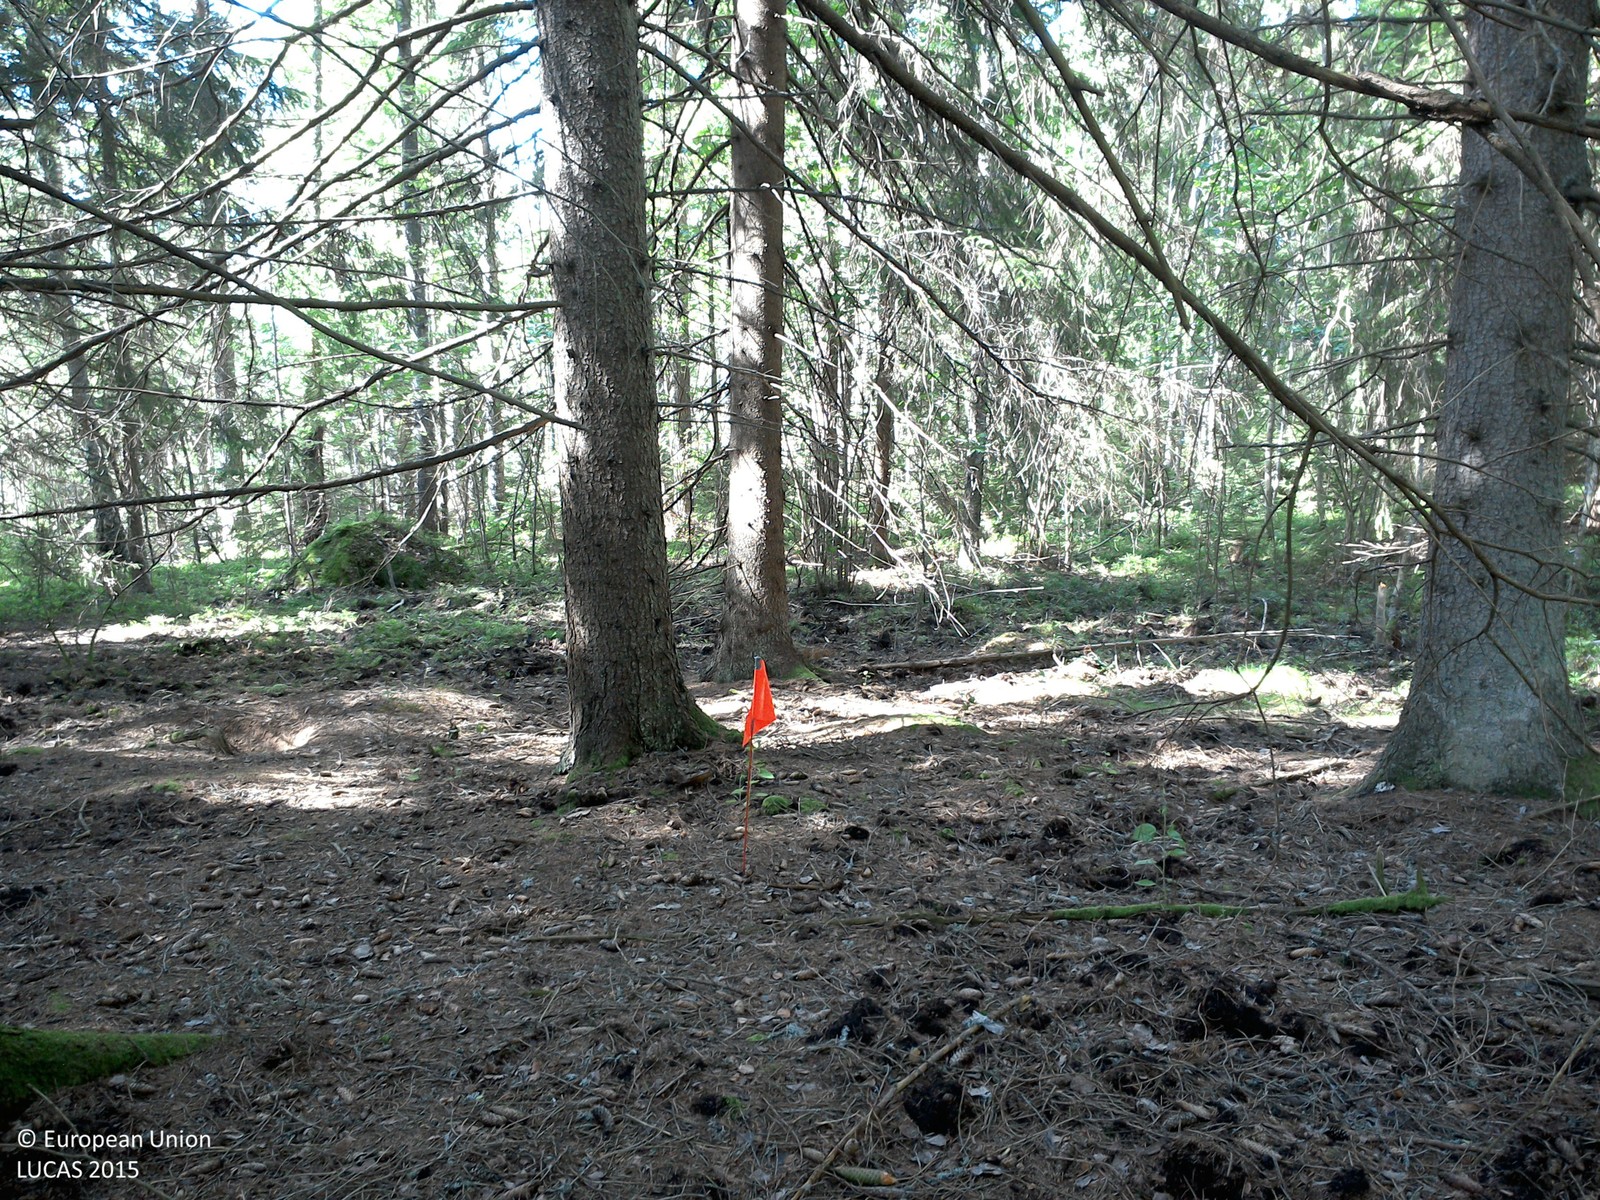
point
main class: Woodland
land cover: Spruce dominated coniferous woodland
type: boreal forest
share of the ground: > 75 %
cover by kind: coniferous forest trees 85 %, unconsolidated bare surface 15 %
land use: Forestry
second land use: Agriculture (excluding fallow land and kitchen gardens)
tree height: > 5 m
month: August
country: SE
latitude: 57.9202
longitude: 15.2118
